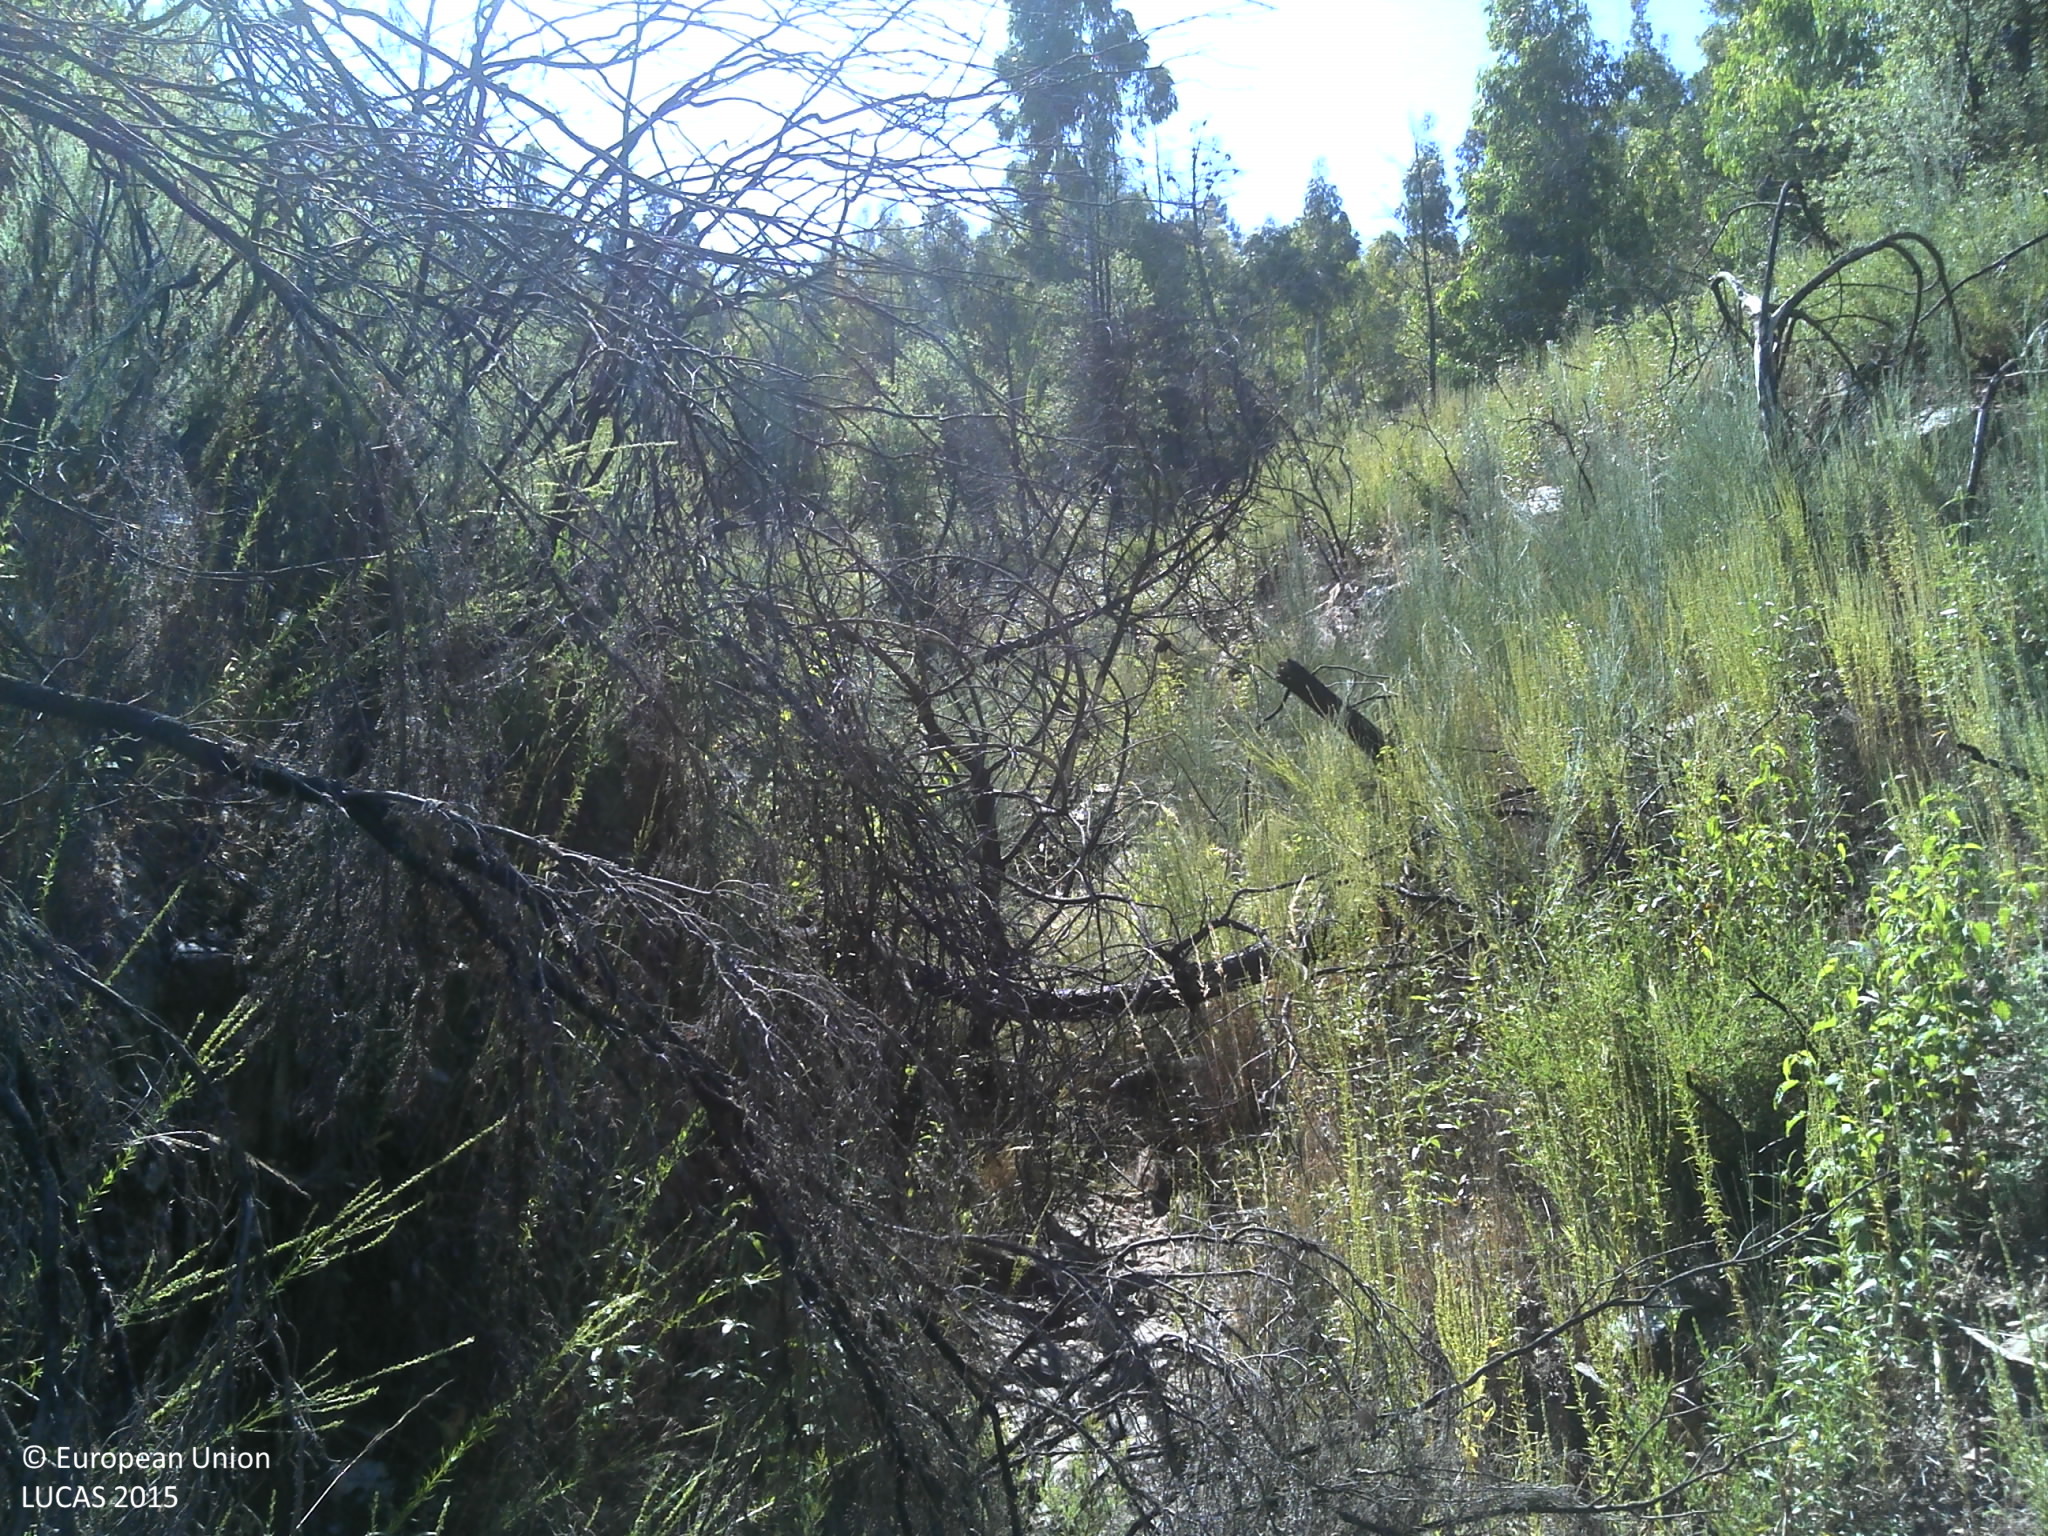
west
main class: Woodland
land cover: Pine dominated coniferous woodland
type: coniferous forest of the mediterranean region
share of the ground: < 10 %
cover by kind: shrubs 80 %, coniferous forest trees 10 %, herbaceous plants 5 %, unconsolidated bare surface 5 %
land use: Abandoned areas
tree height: > 5 m
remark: Burnt area
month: June
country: PT
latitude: 41.2001
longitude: -6.8119
